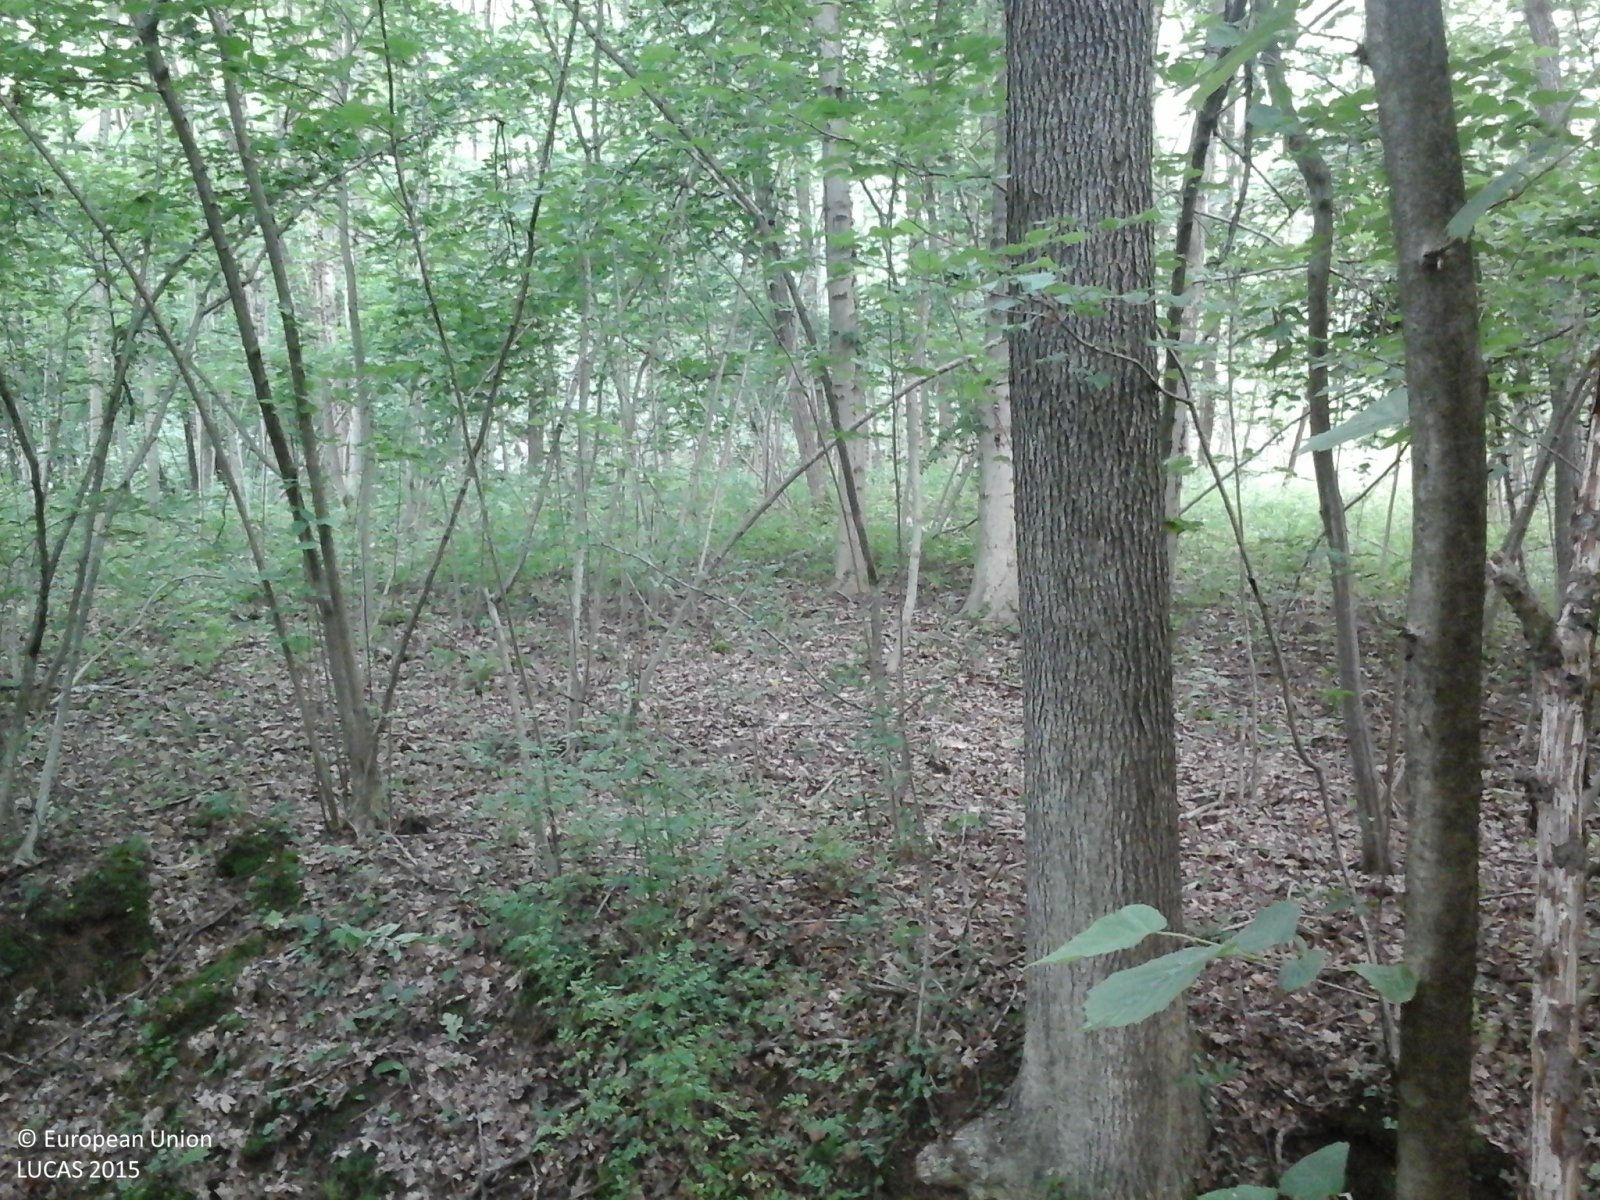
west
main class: Woodland
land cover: Broadleaved woodland
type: mesophytic deciduous forest
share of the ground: > 75 %
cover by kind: broadleaved forest trees 100 %
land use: Forestry
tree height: > 5 m
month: May
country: IT
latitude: 45.5791
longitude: 8.1958
